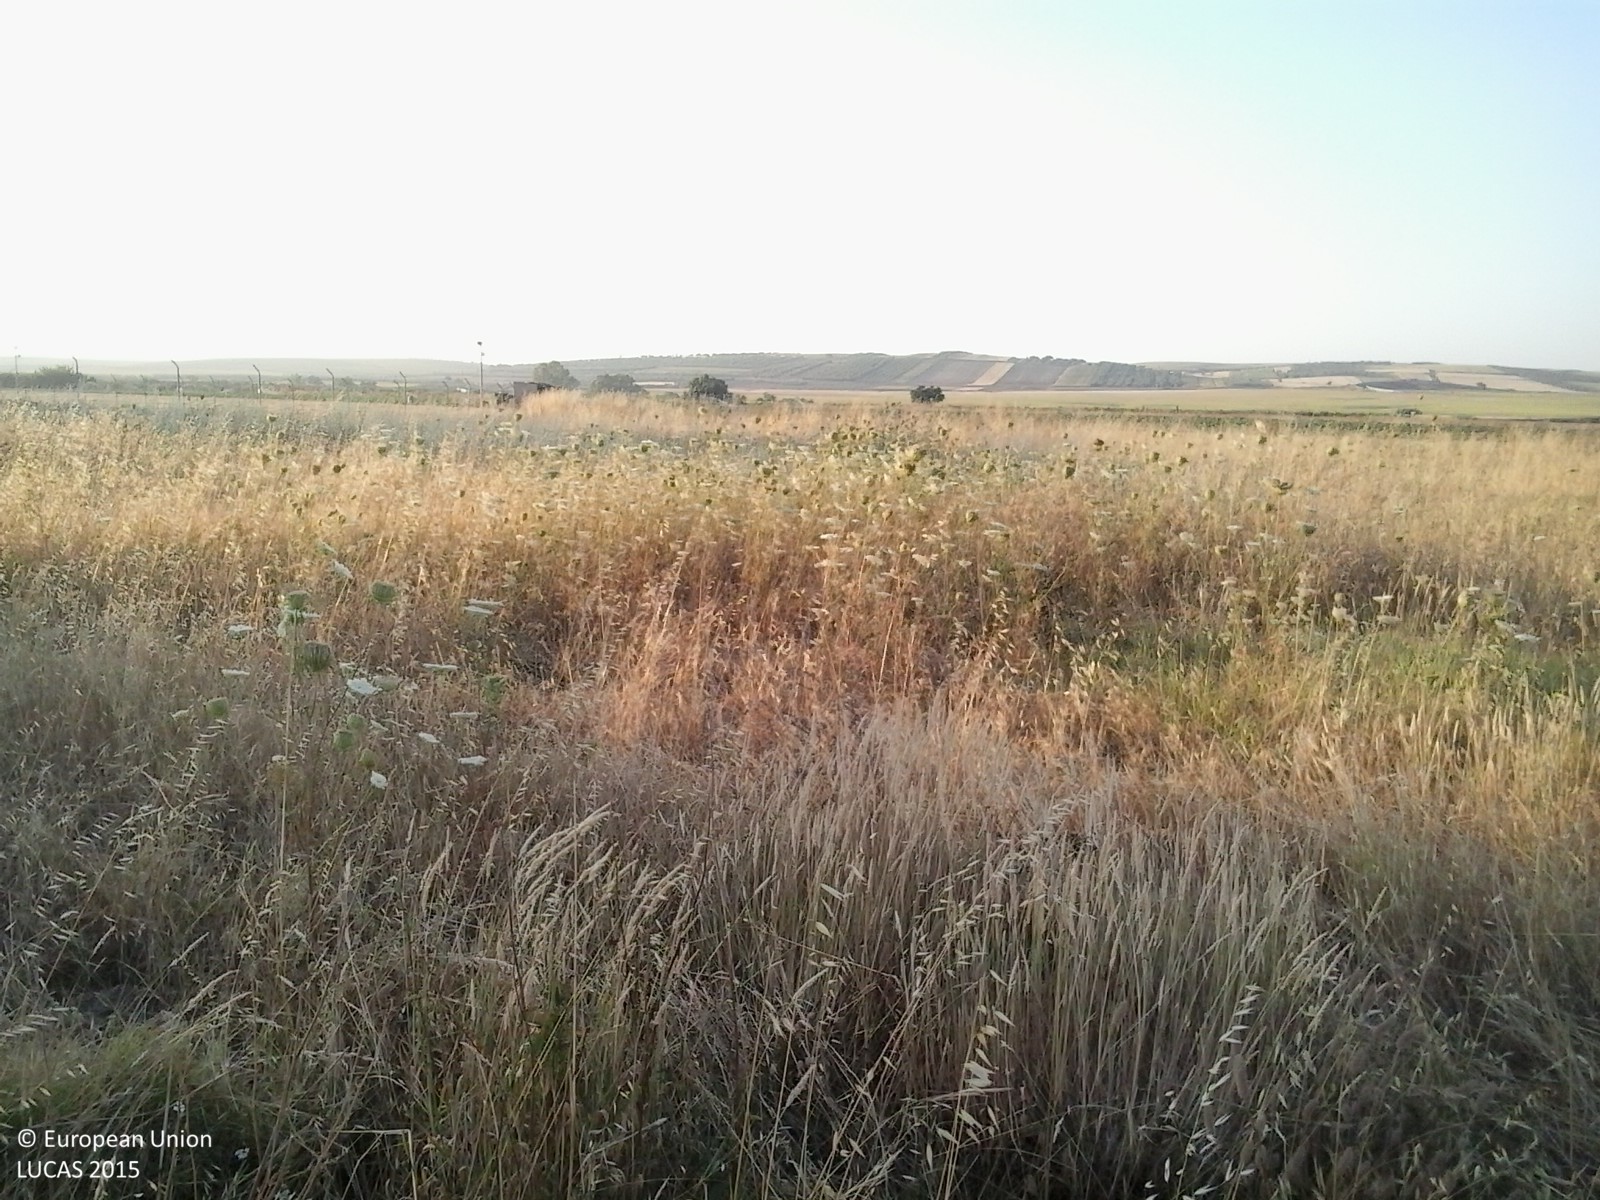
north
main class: Grassland
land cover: Grassland without tree/shrub cover
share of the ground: > 75 %
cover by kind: herbaceous plants 90 %, shrubs 5 %, unconsolidated bare surface 5 %
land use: Abandoned areas
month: June
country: ES
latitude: 37.3981
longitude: -6.4220
